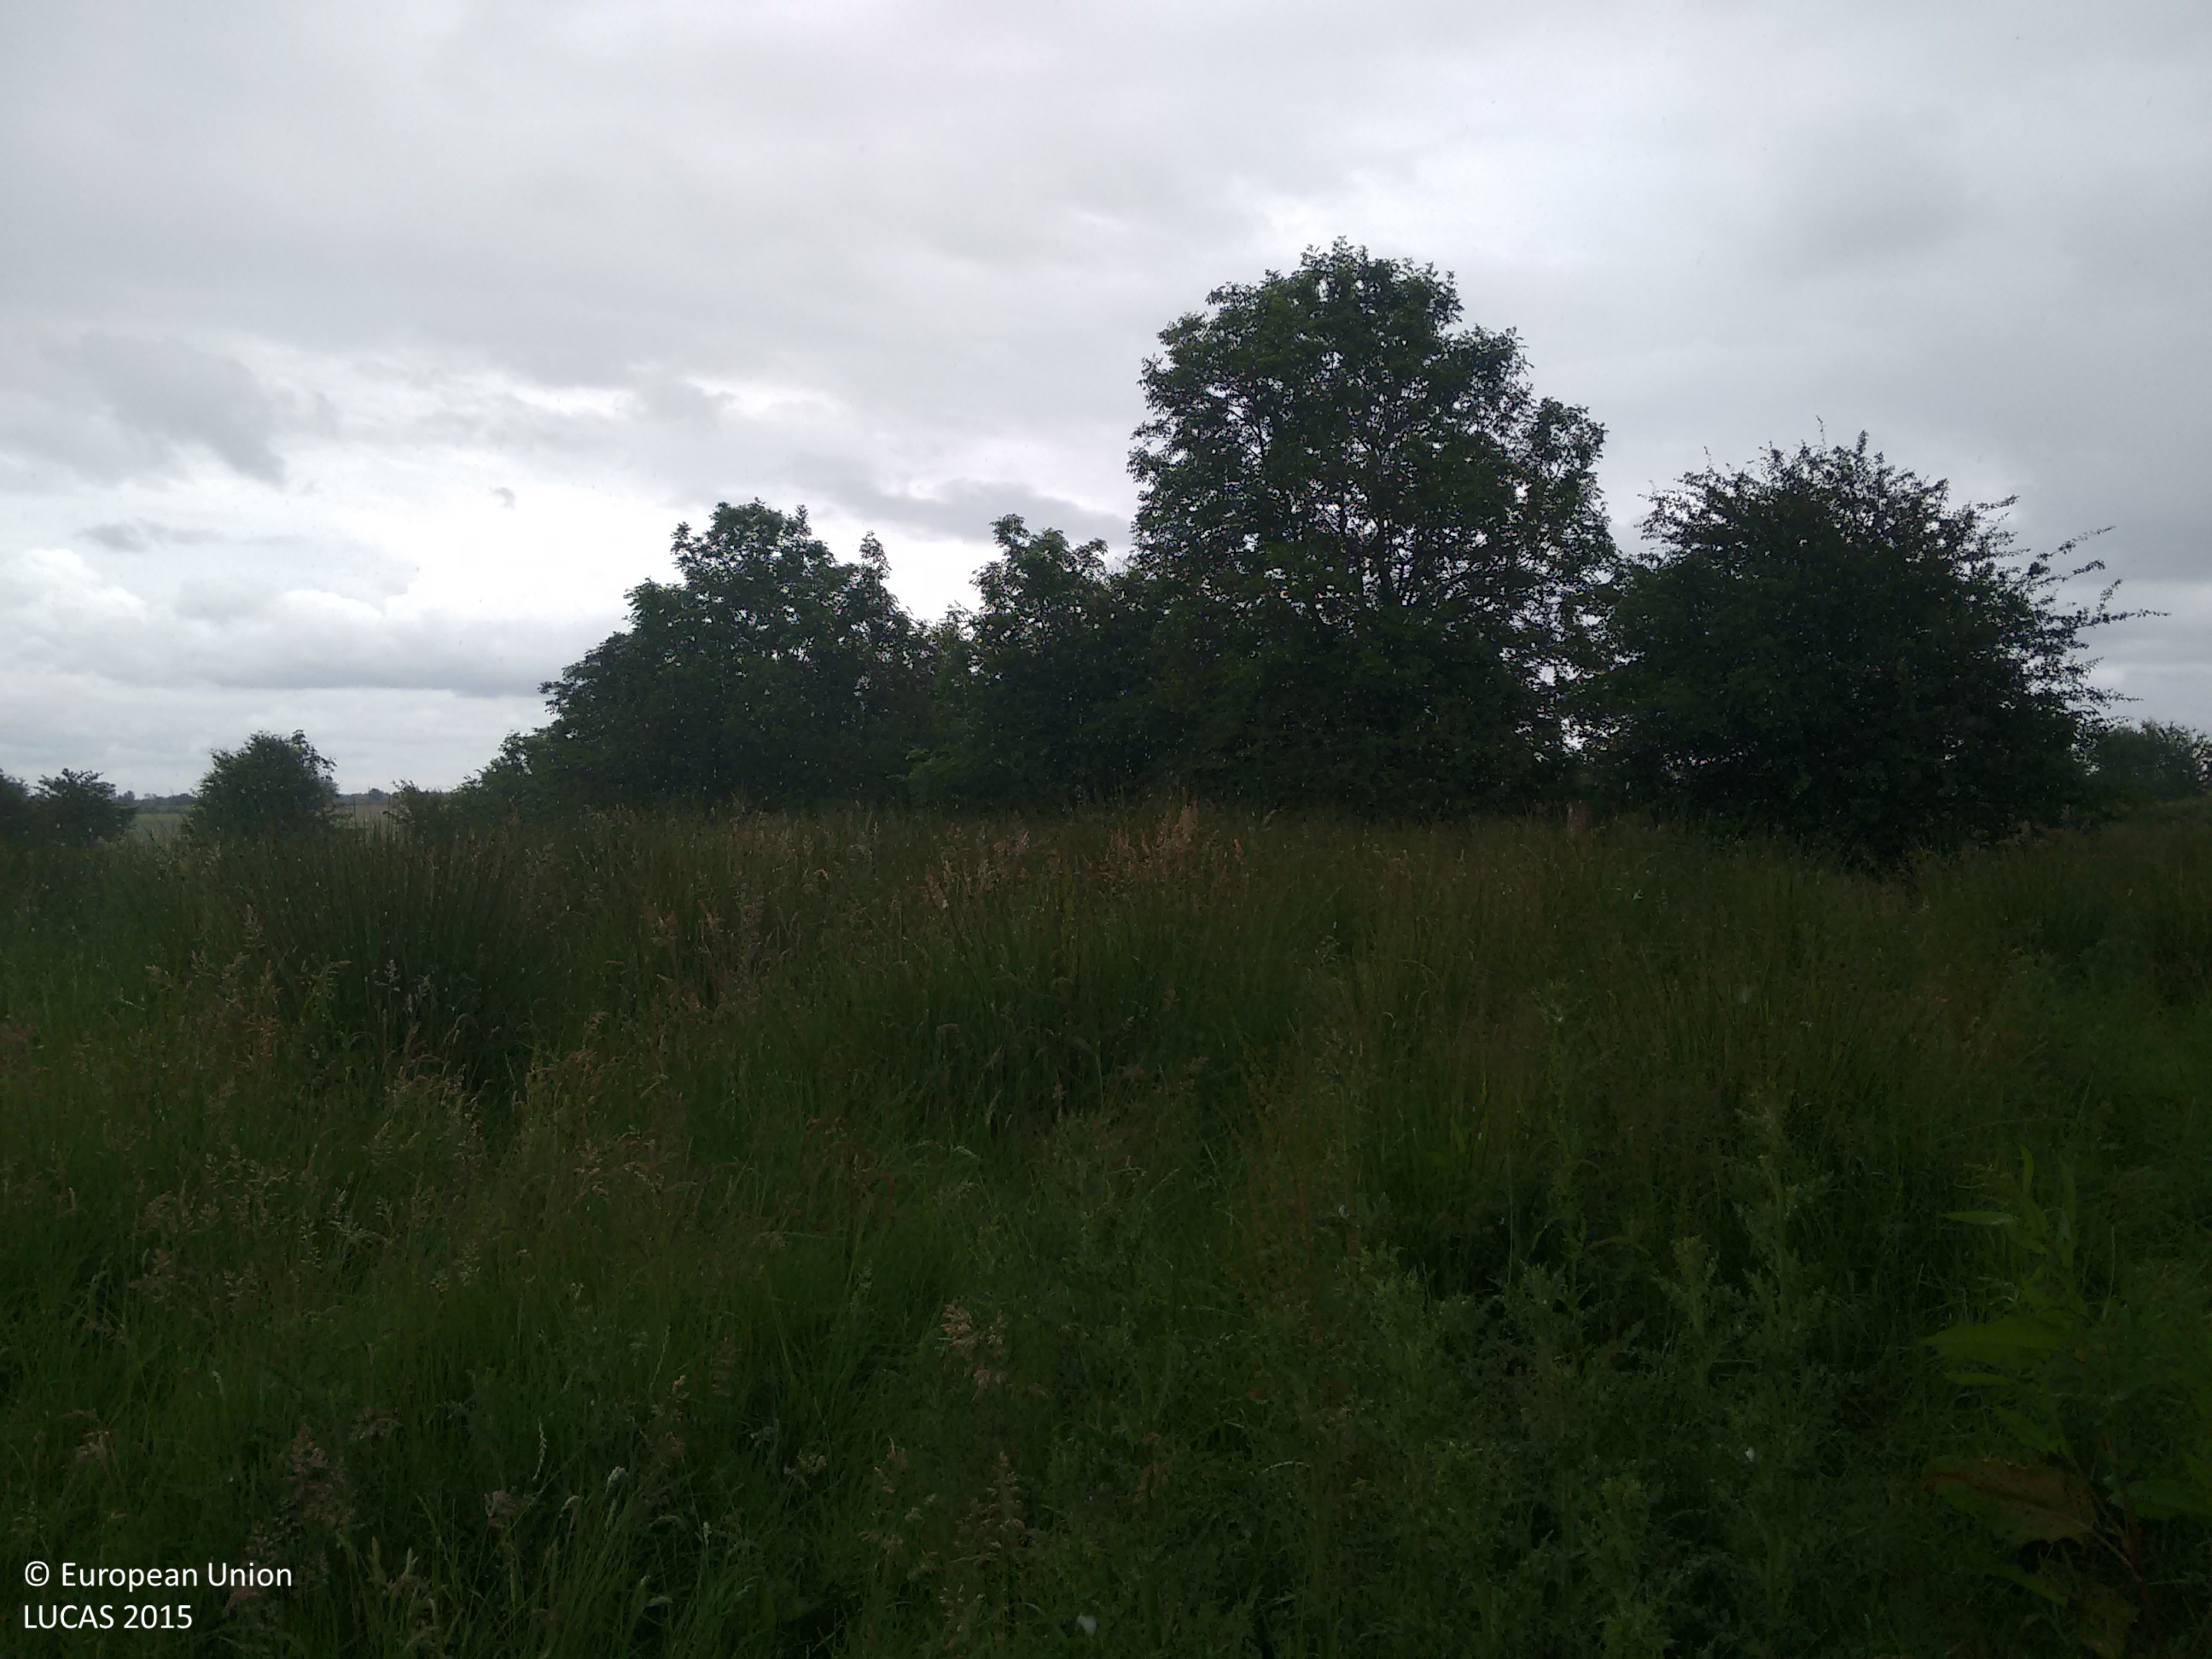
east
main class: Grassland
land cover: Grassland without tree/shrub cover
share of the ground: > 75 %
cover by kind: herbaceous plants 100 %
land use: Agriculture (excluding fallow land and kitchen gardens)
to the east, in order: Grassland without tree/shrub cover; Fences; Ditches and canals; Abandoned hedges; Fences; Abandoned hedges; Grassland without tree/shrub cover; Artificial constructions; Fences; Ditches and canals; Grassland without tree/shrub cover
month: July
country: IE
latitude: 53.5888
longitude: -8.7071
